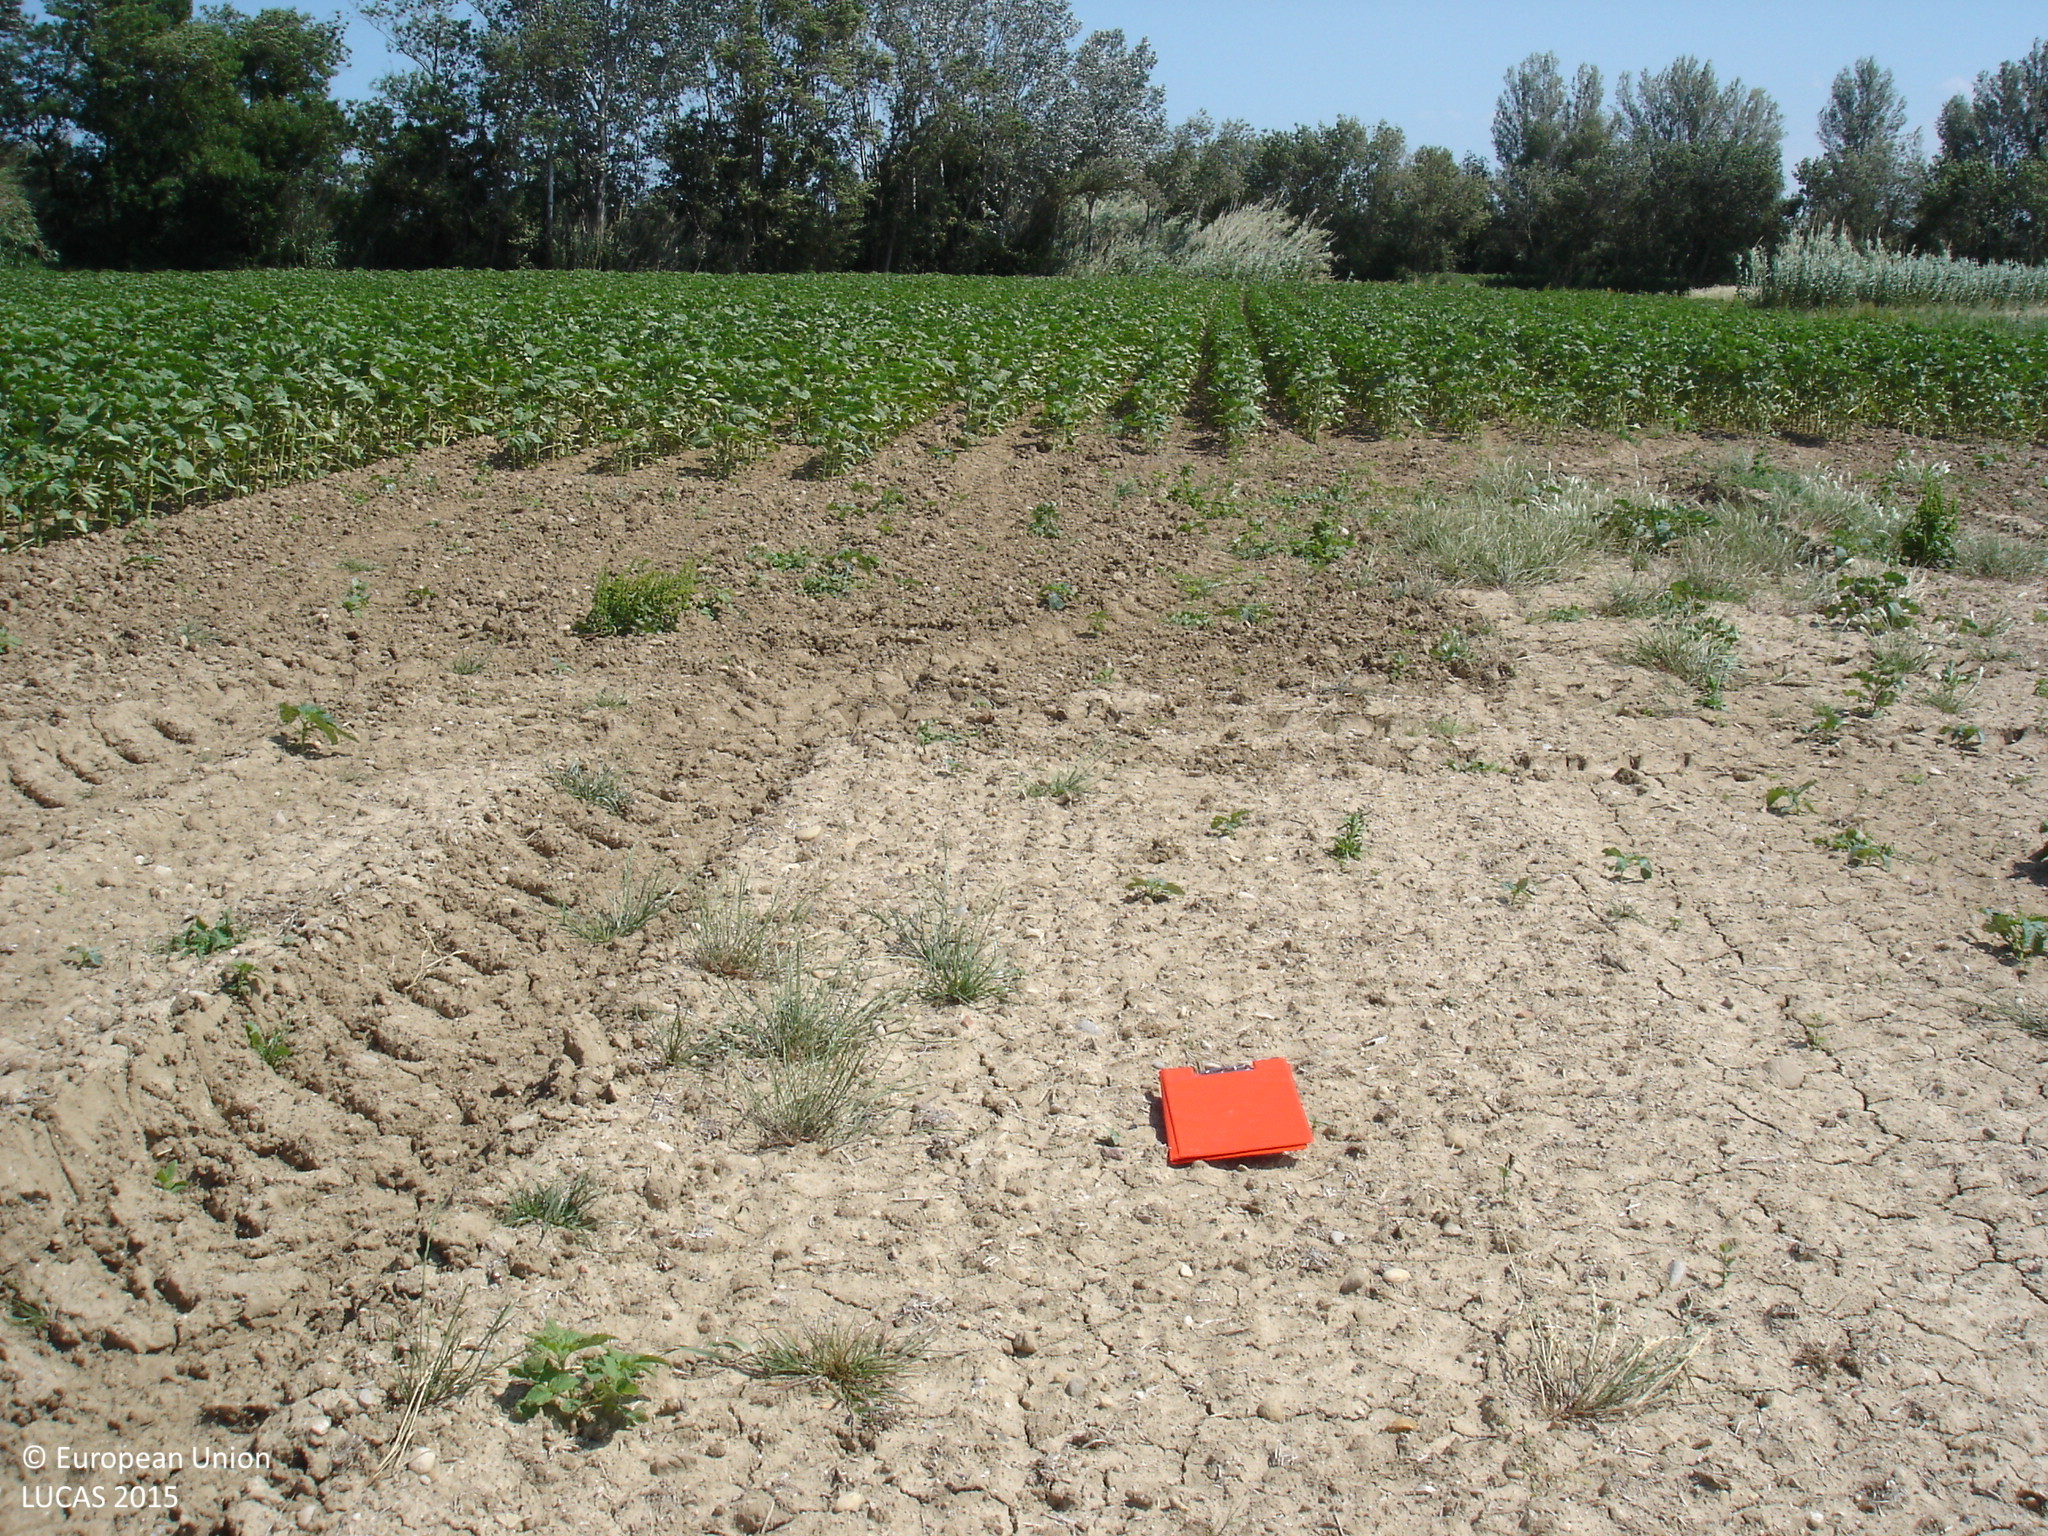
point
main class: Grassland
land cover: Grassland without tree/shrub cover
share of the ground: 10 - 25 %
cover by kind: consolidated bare surface 90 %, herbaceous plants 10 %
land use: Agriculture (excluding fallow land and kitchen gardens)
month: May
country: ES
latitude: 42.2124
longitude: 3.0010
